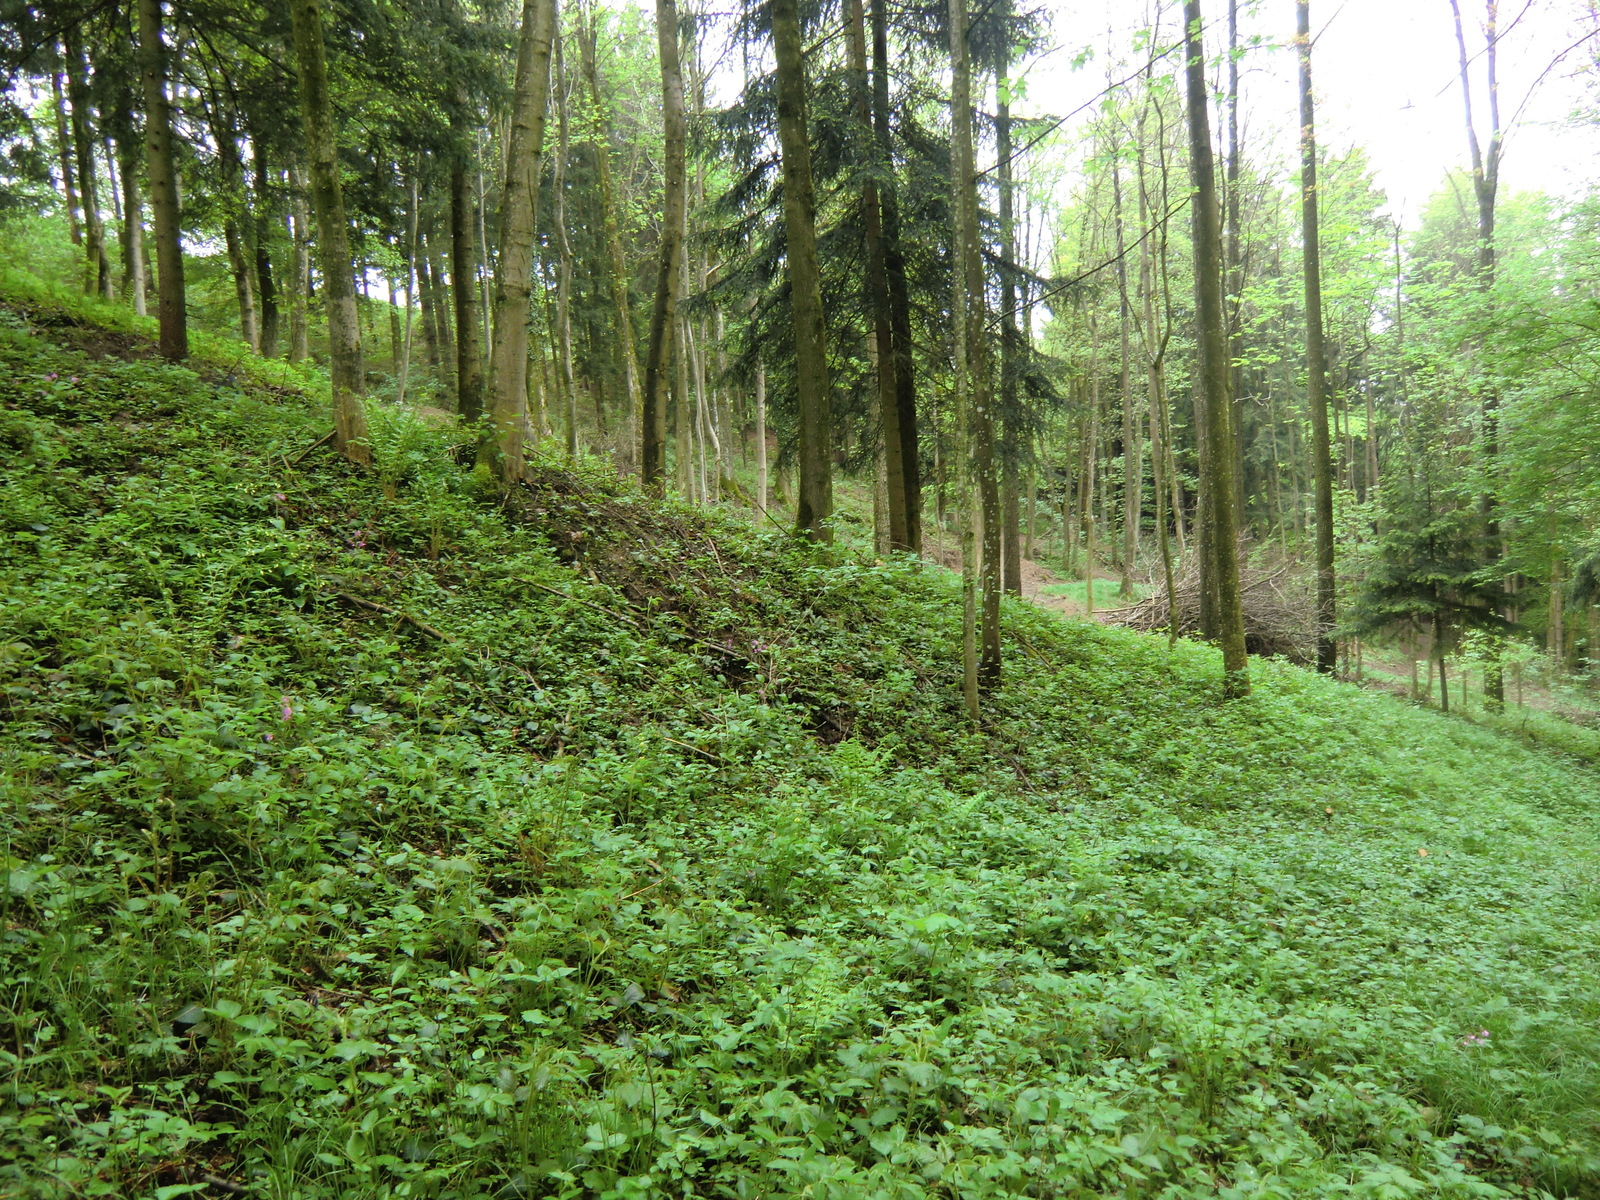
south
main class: Woodland
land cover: Spruce dominated mixed woodland
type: mountainous beech forest
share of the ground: 50 - 75 %
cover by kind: coniferous forest trees 35 %, broadleaved forest trees 35 %, shrubs 15 %, herbaceous plants 15 %
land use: Forestry
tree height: > 5 m
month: May
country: AT
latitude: 48.2831
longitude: 14.7580
